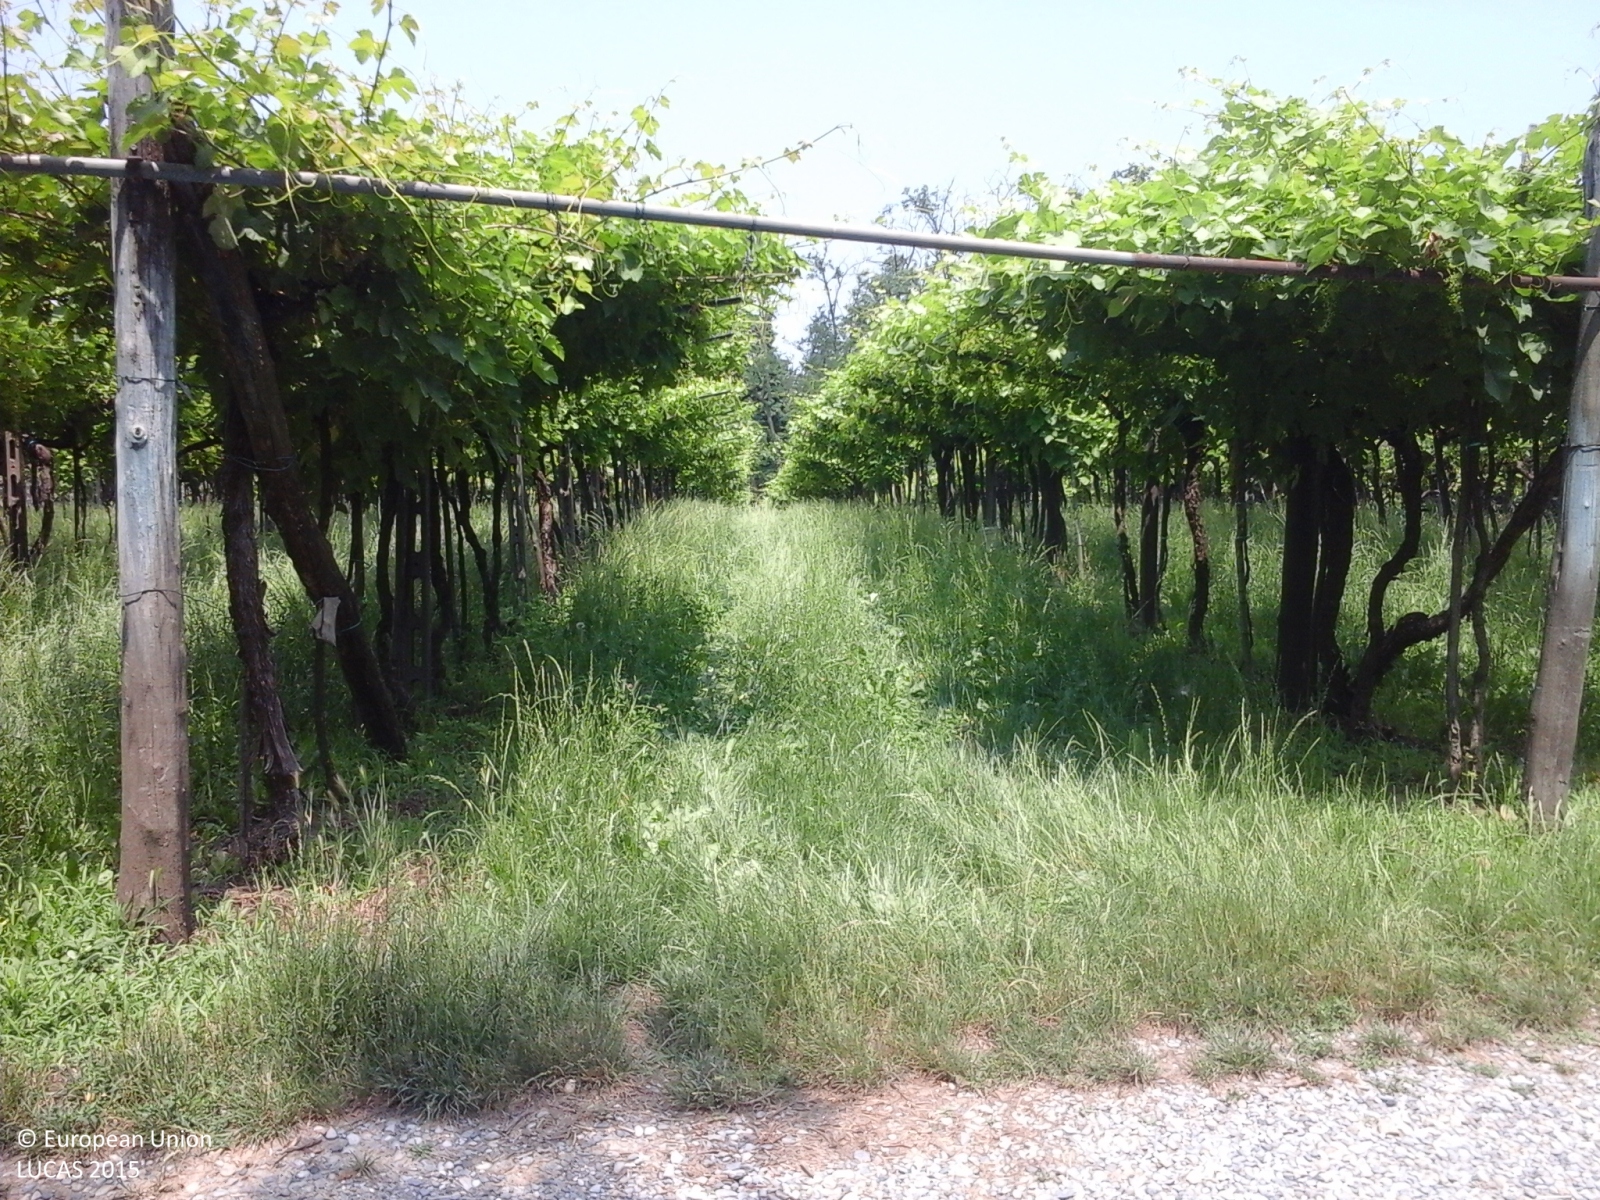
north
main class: Woodland
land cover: Broadleaved woodland
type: thermophilous deciduous forest
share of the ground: > 75 %
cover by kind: broadleaved forest trees 100 %
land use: Forestry
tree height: > 5 m
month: June
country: IT
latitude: 45.1786
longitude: 9.4538
